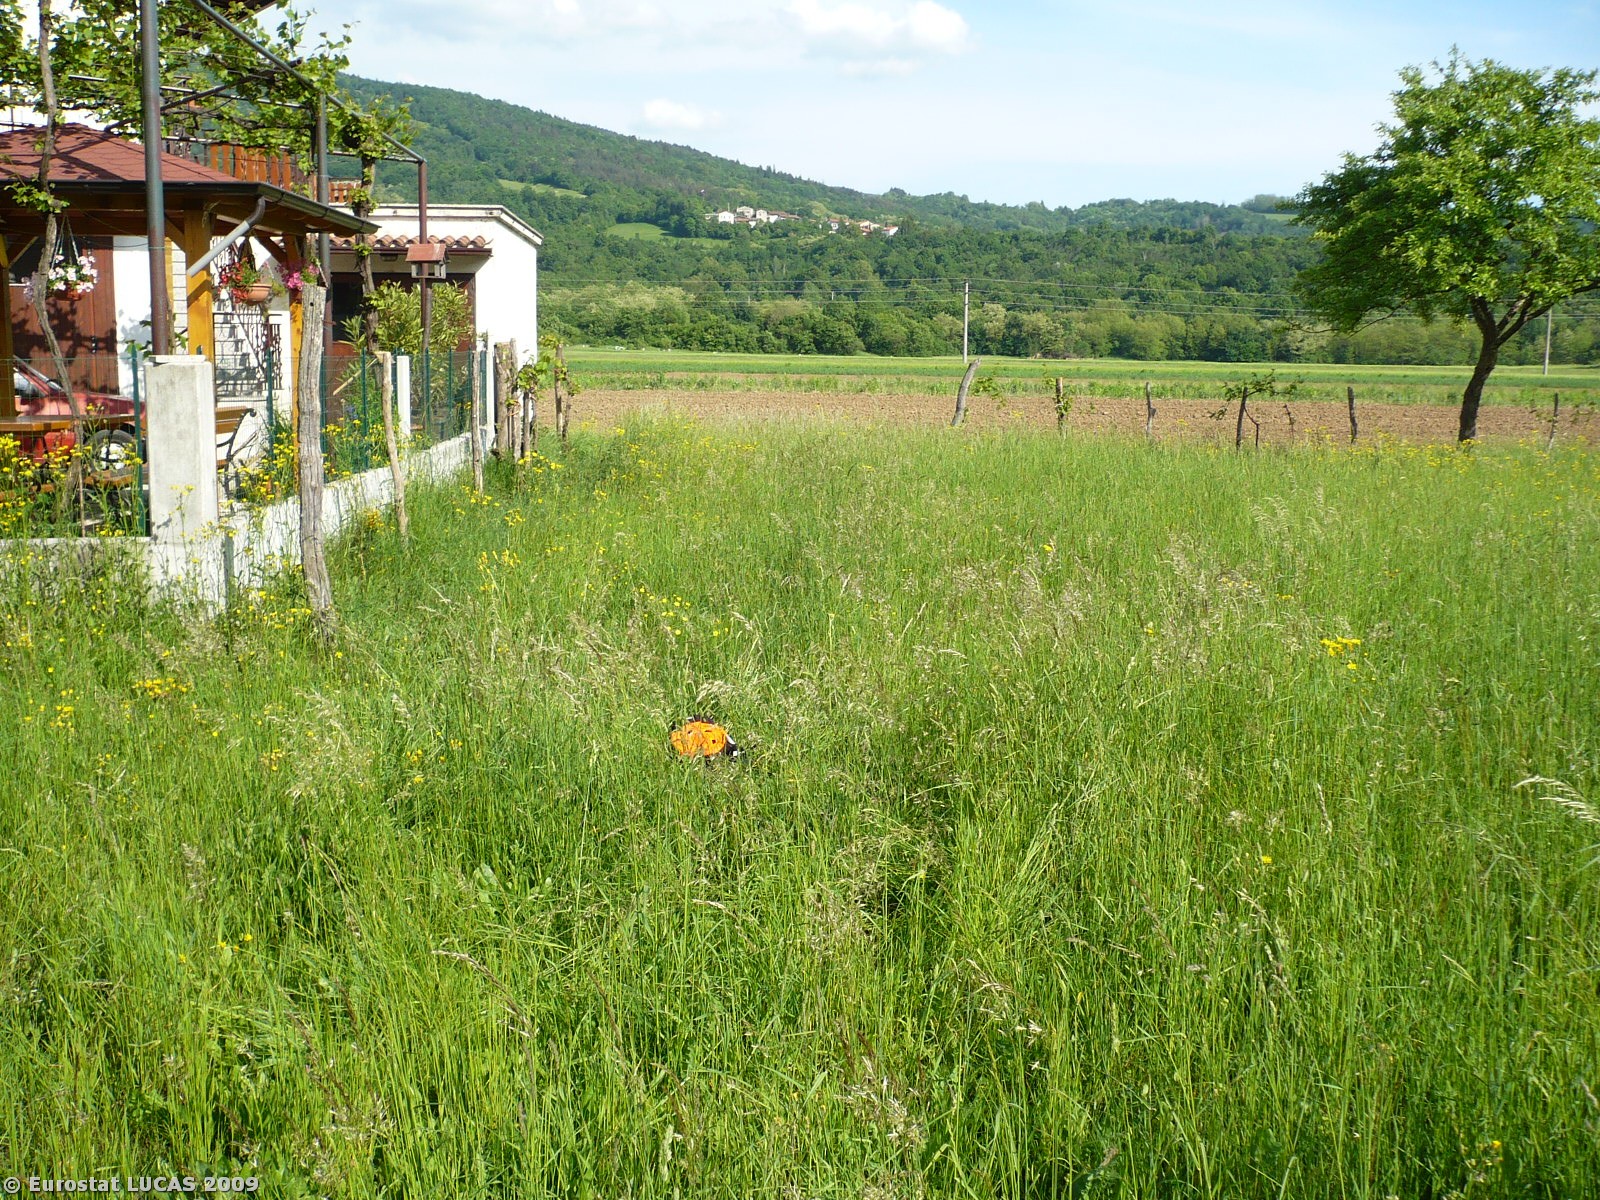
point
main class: Grassland
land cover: Grassland without tree/shrub cover
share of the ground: > 75 %
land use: Agriculture (excluding fallow land and kitchen gardens)
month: May
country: SI
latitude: 45.9995
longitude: 13.6762
